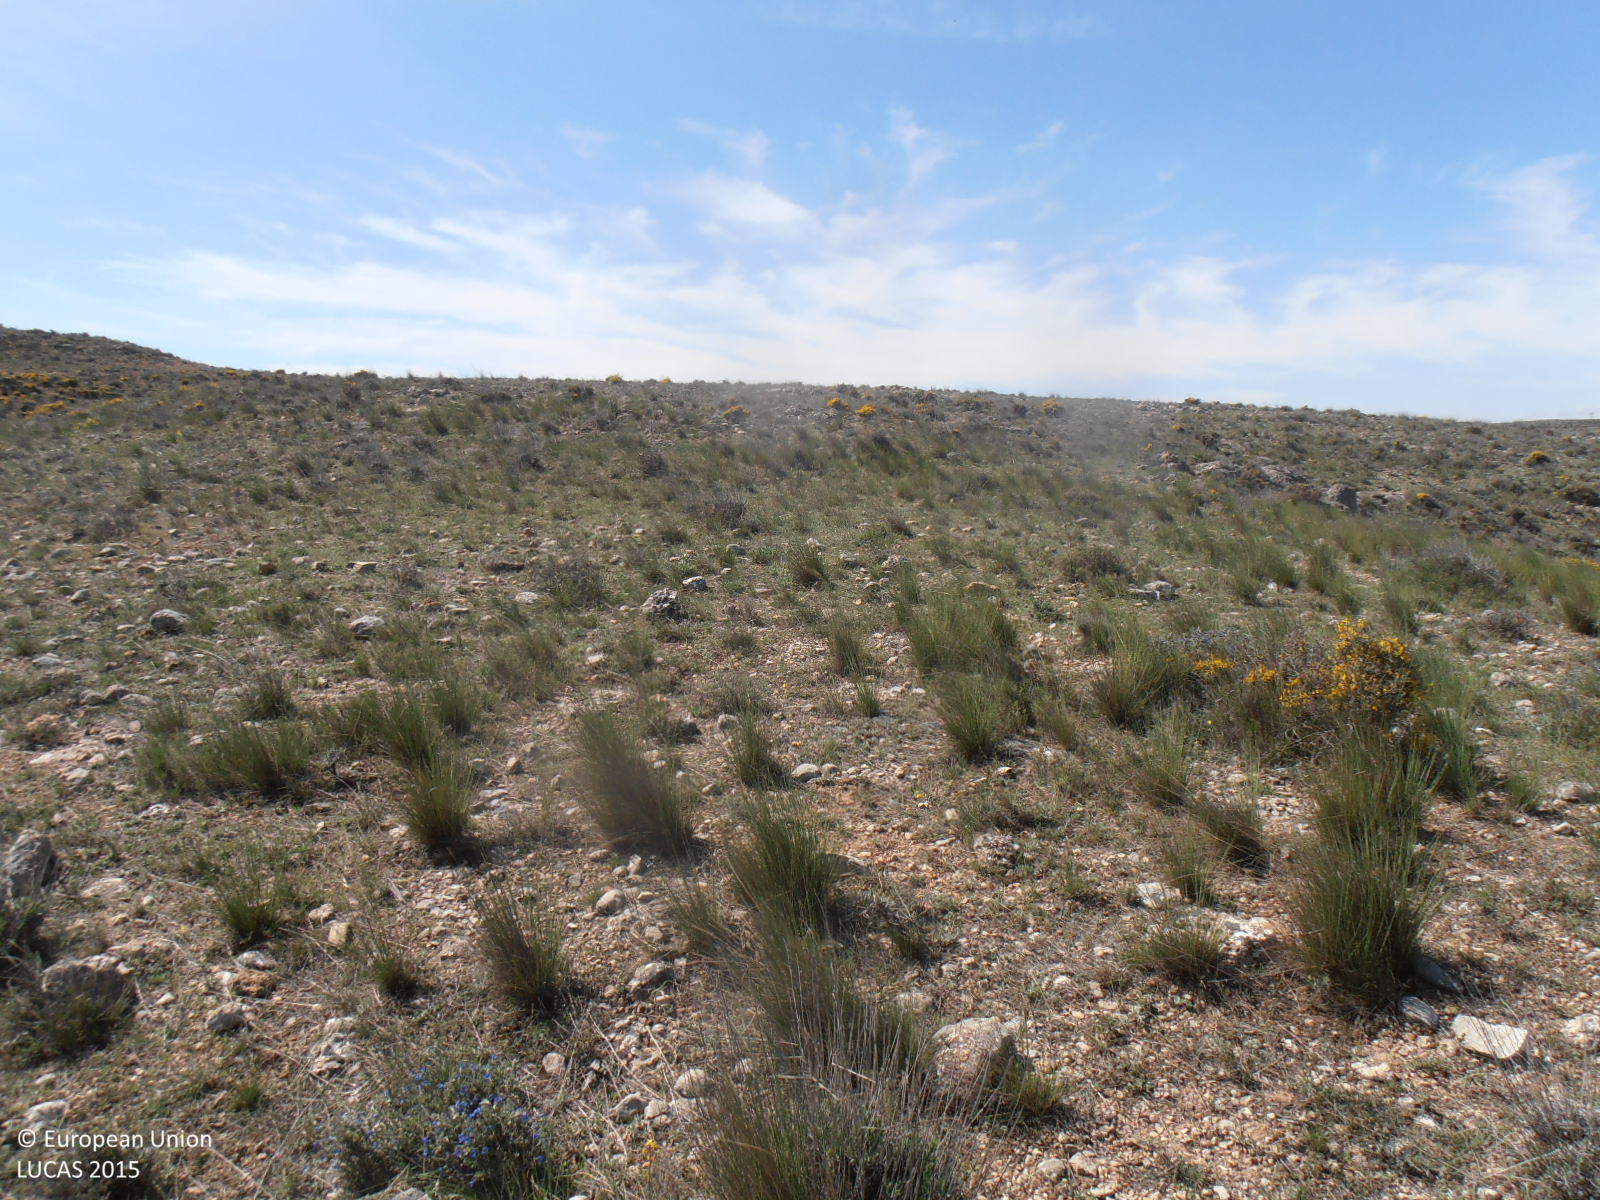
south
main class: Shrubland
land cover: Shrubland without tree cover
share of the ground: 50 - 75 %
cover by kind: shrubs 60 %, consolidated bare surface 30 %, herbaceous plants 10 %
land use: Semi-natural and natural areas not in use
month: April
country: ES
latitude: 41.2046
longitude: -0.9297
